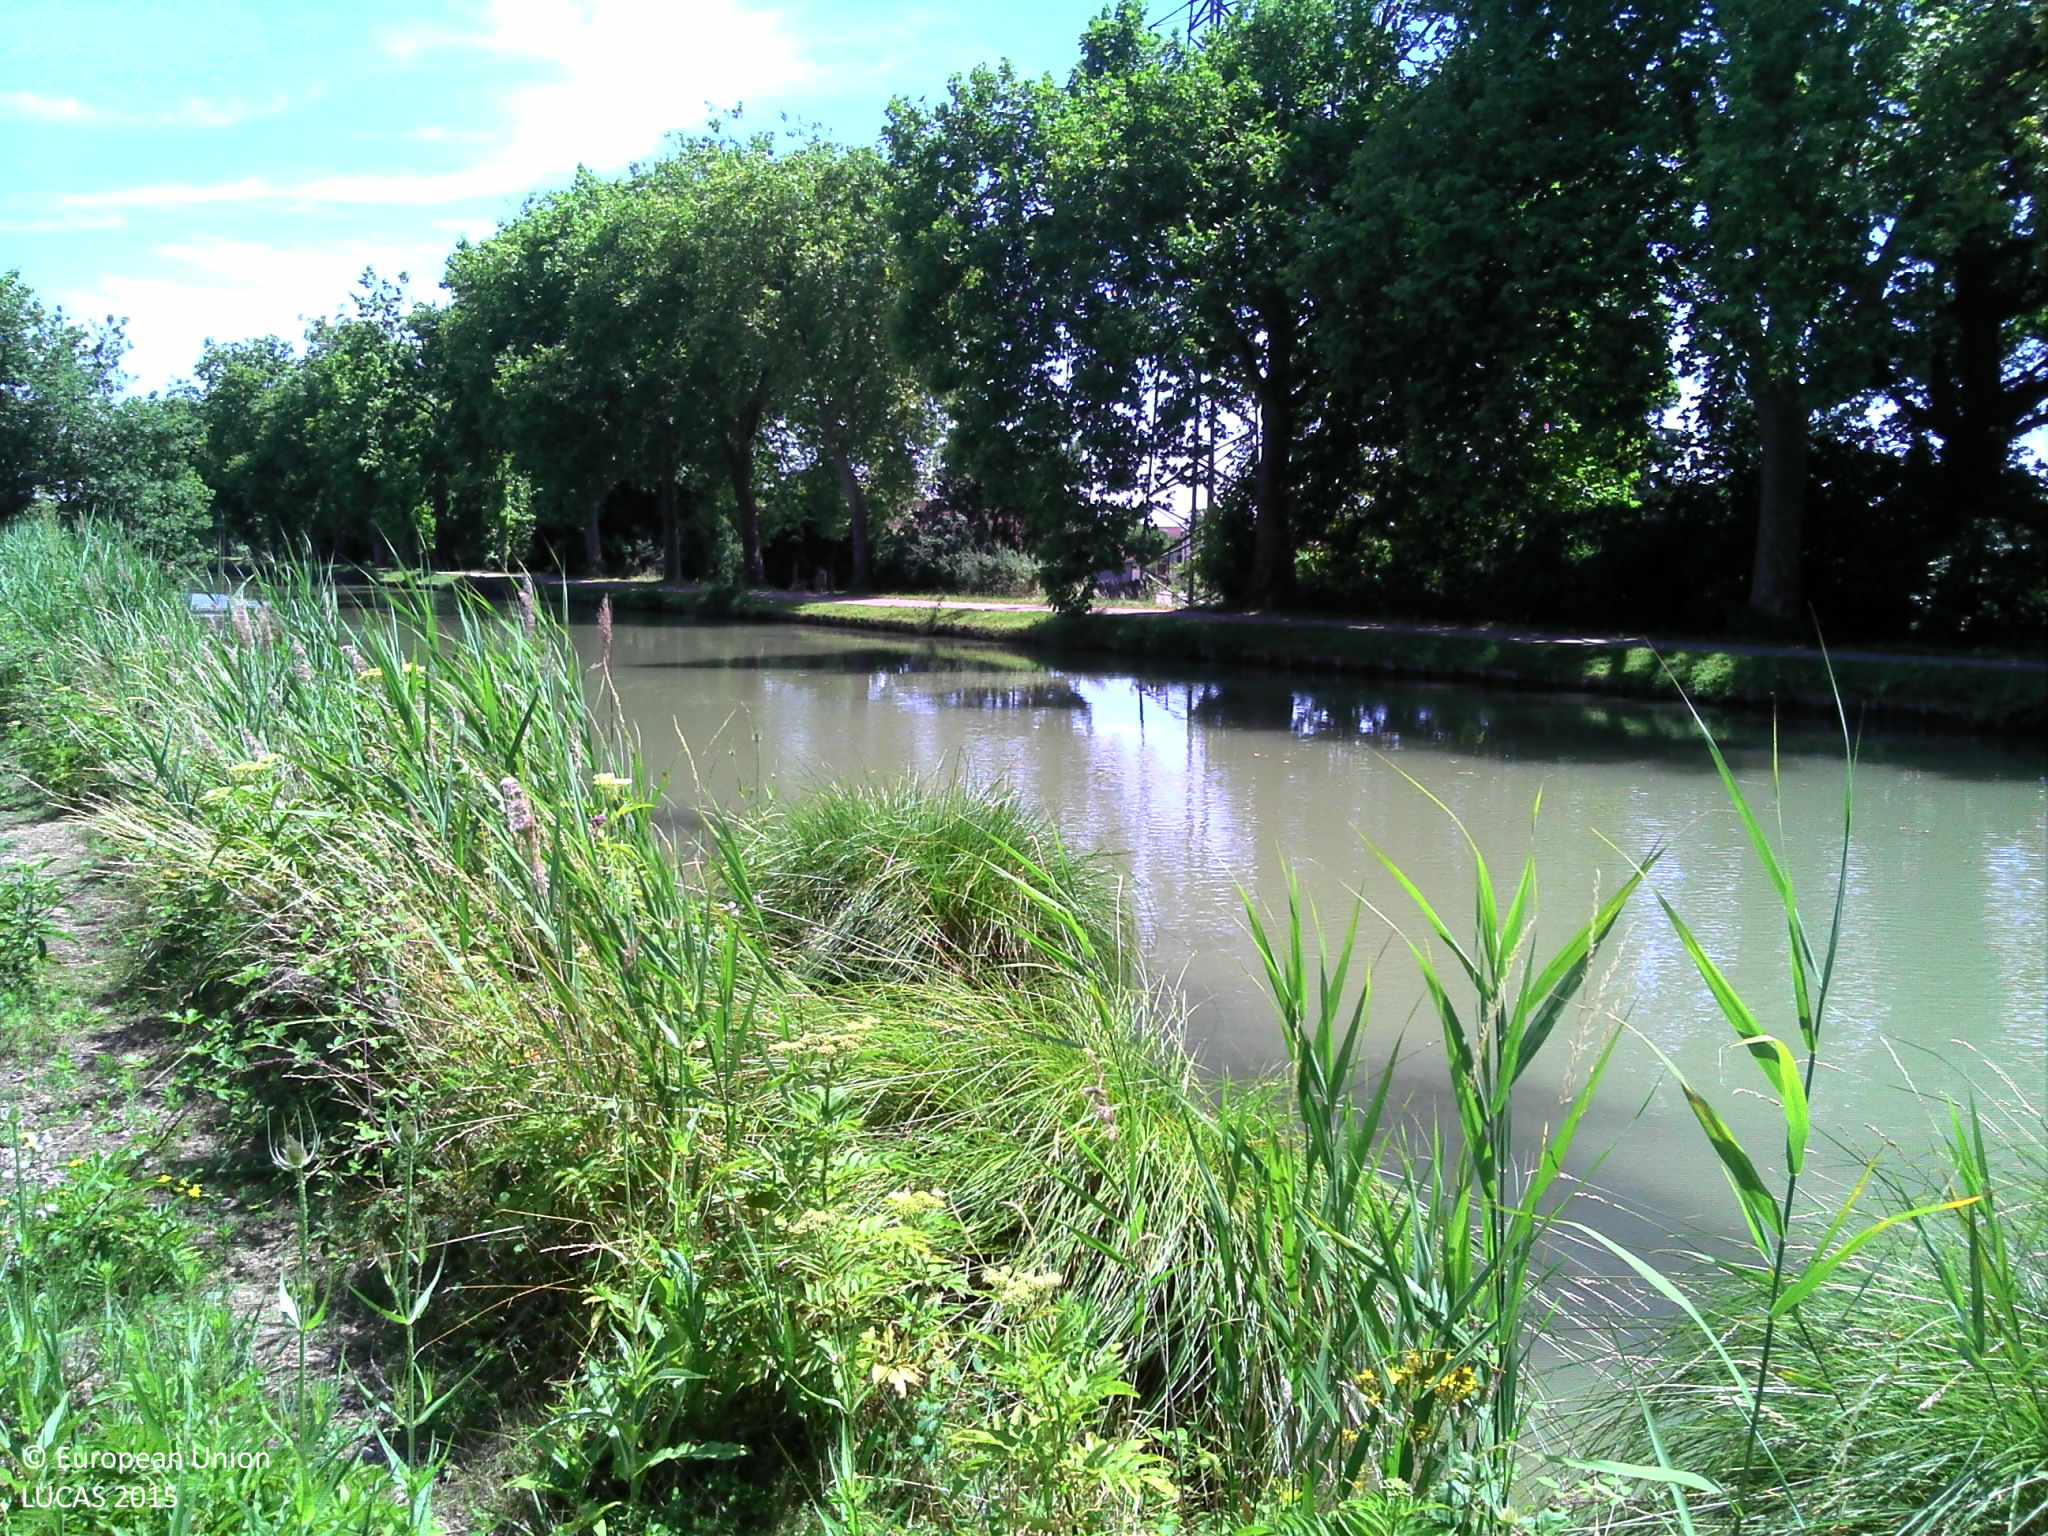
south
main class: Shrubland
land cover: Shrubland with sparse tree cover
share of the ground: > 75 %
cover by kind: shrubs 60 %, herbaceous plants 20 %, consolidated bare surface 15 %, broadleaved forest trees 5 %
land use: Semi-natural and natural areas not in use
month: June
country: FR
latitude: 43.7368
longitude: 1.3723
